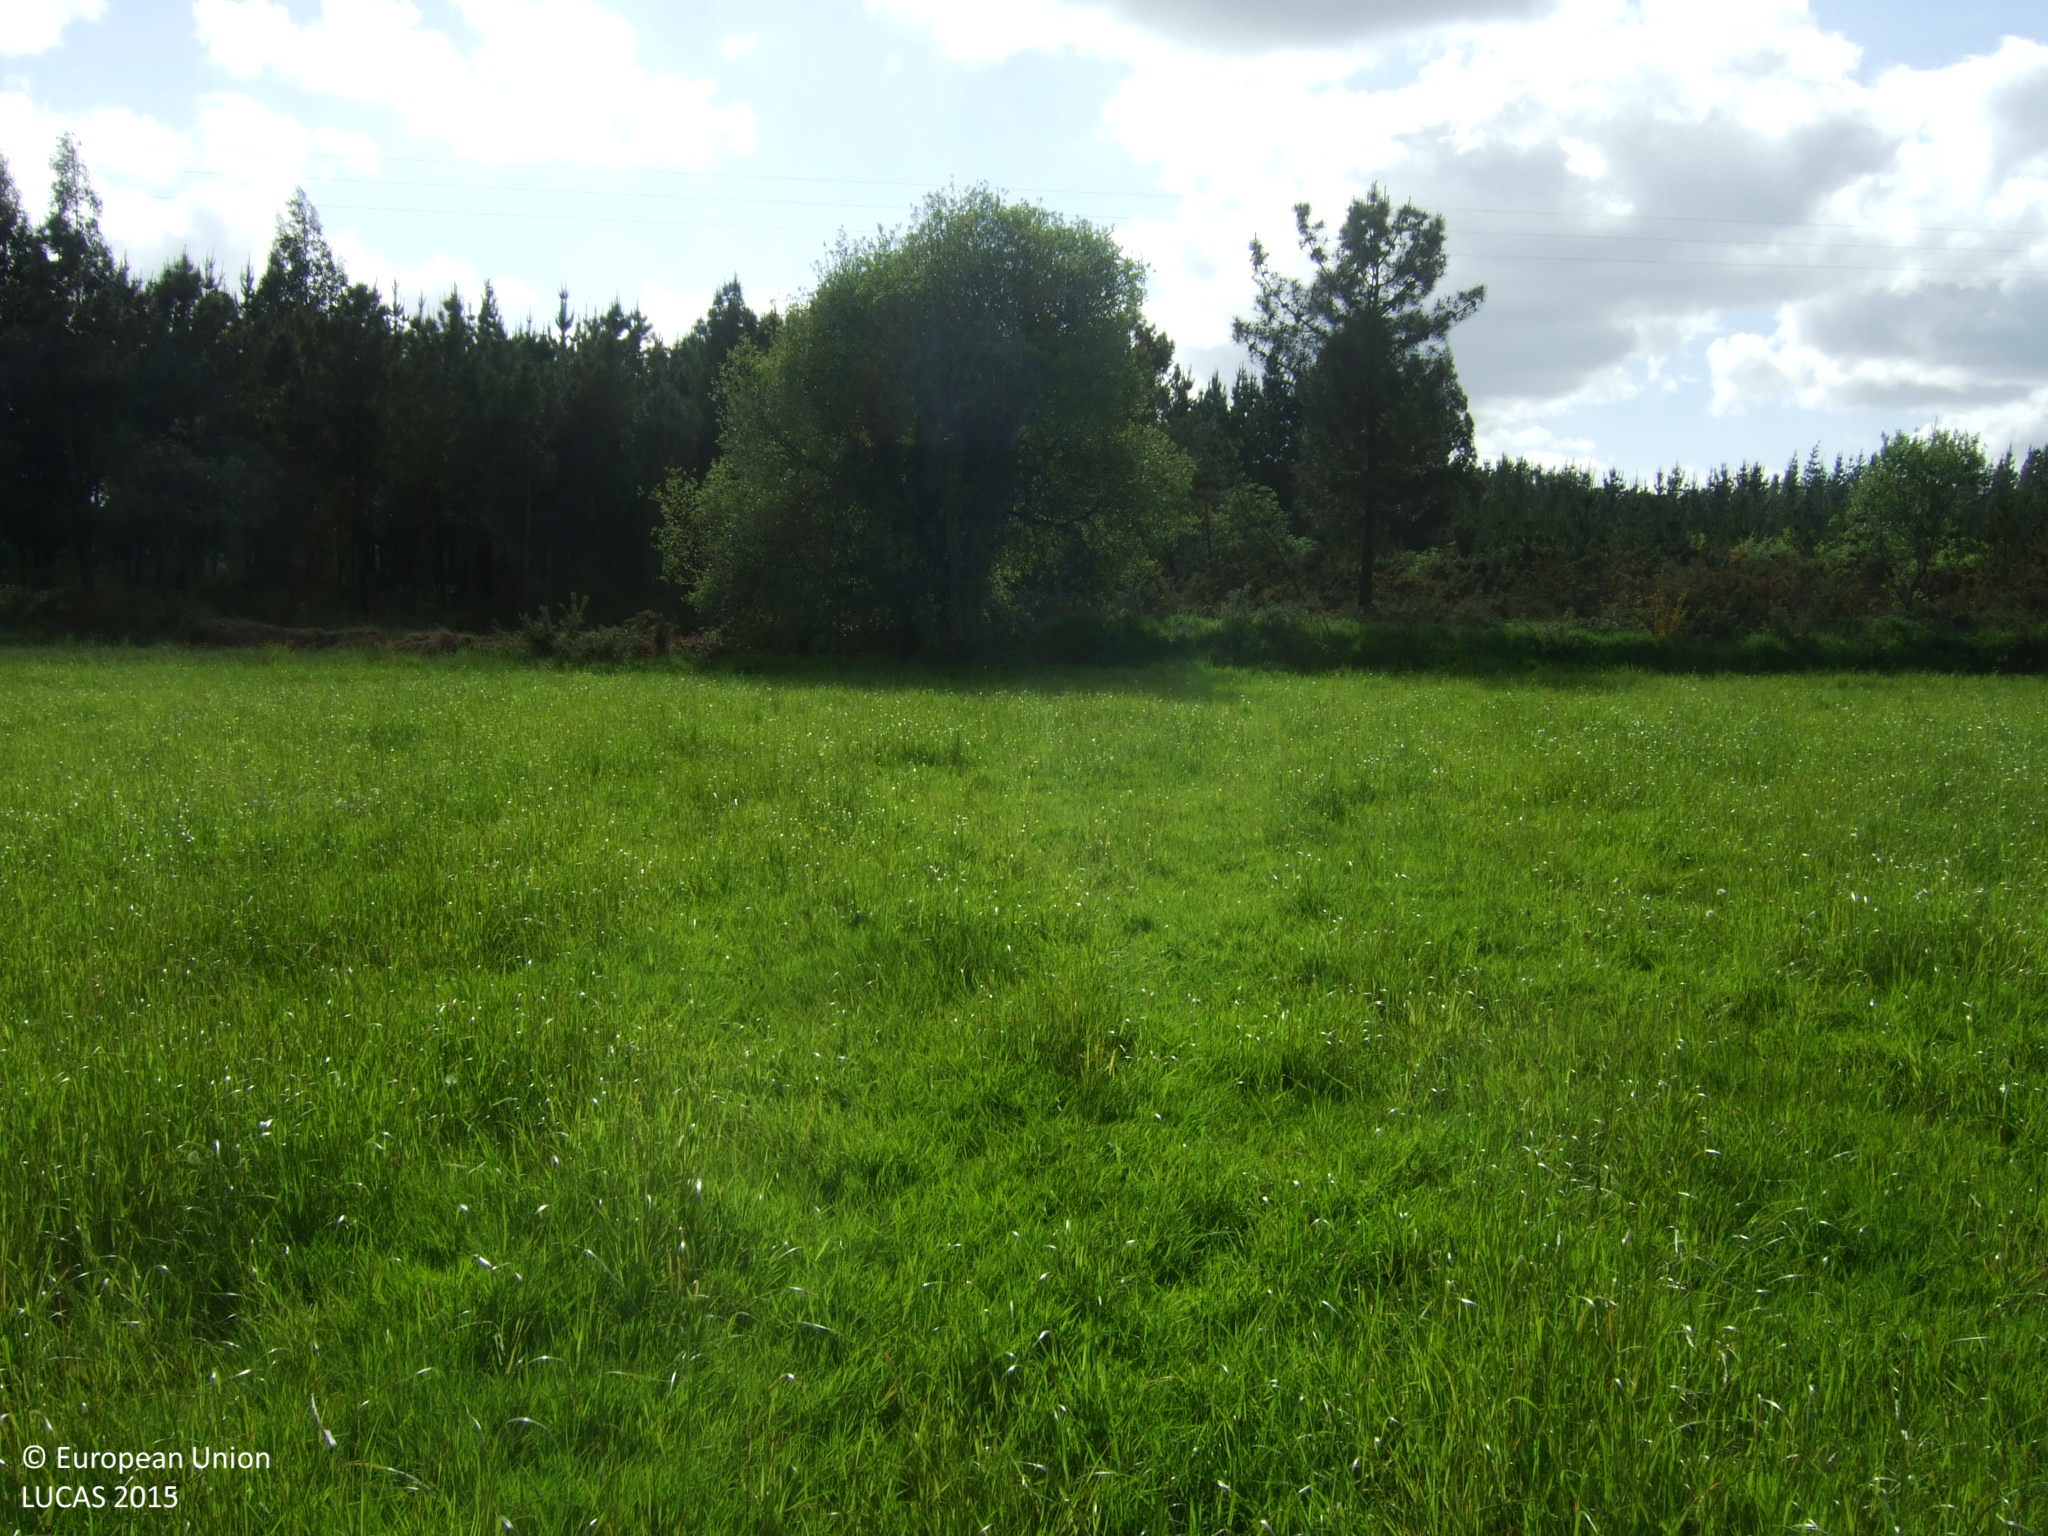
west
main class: Cropland
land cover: Temporary grasslands
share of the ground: > 75 %
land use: Agriculture (excluding fallow land and kitchen gardens)
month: May
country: ES
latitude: 43.2223
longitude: -7.4732
